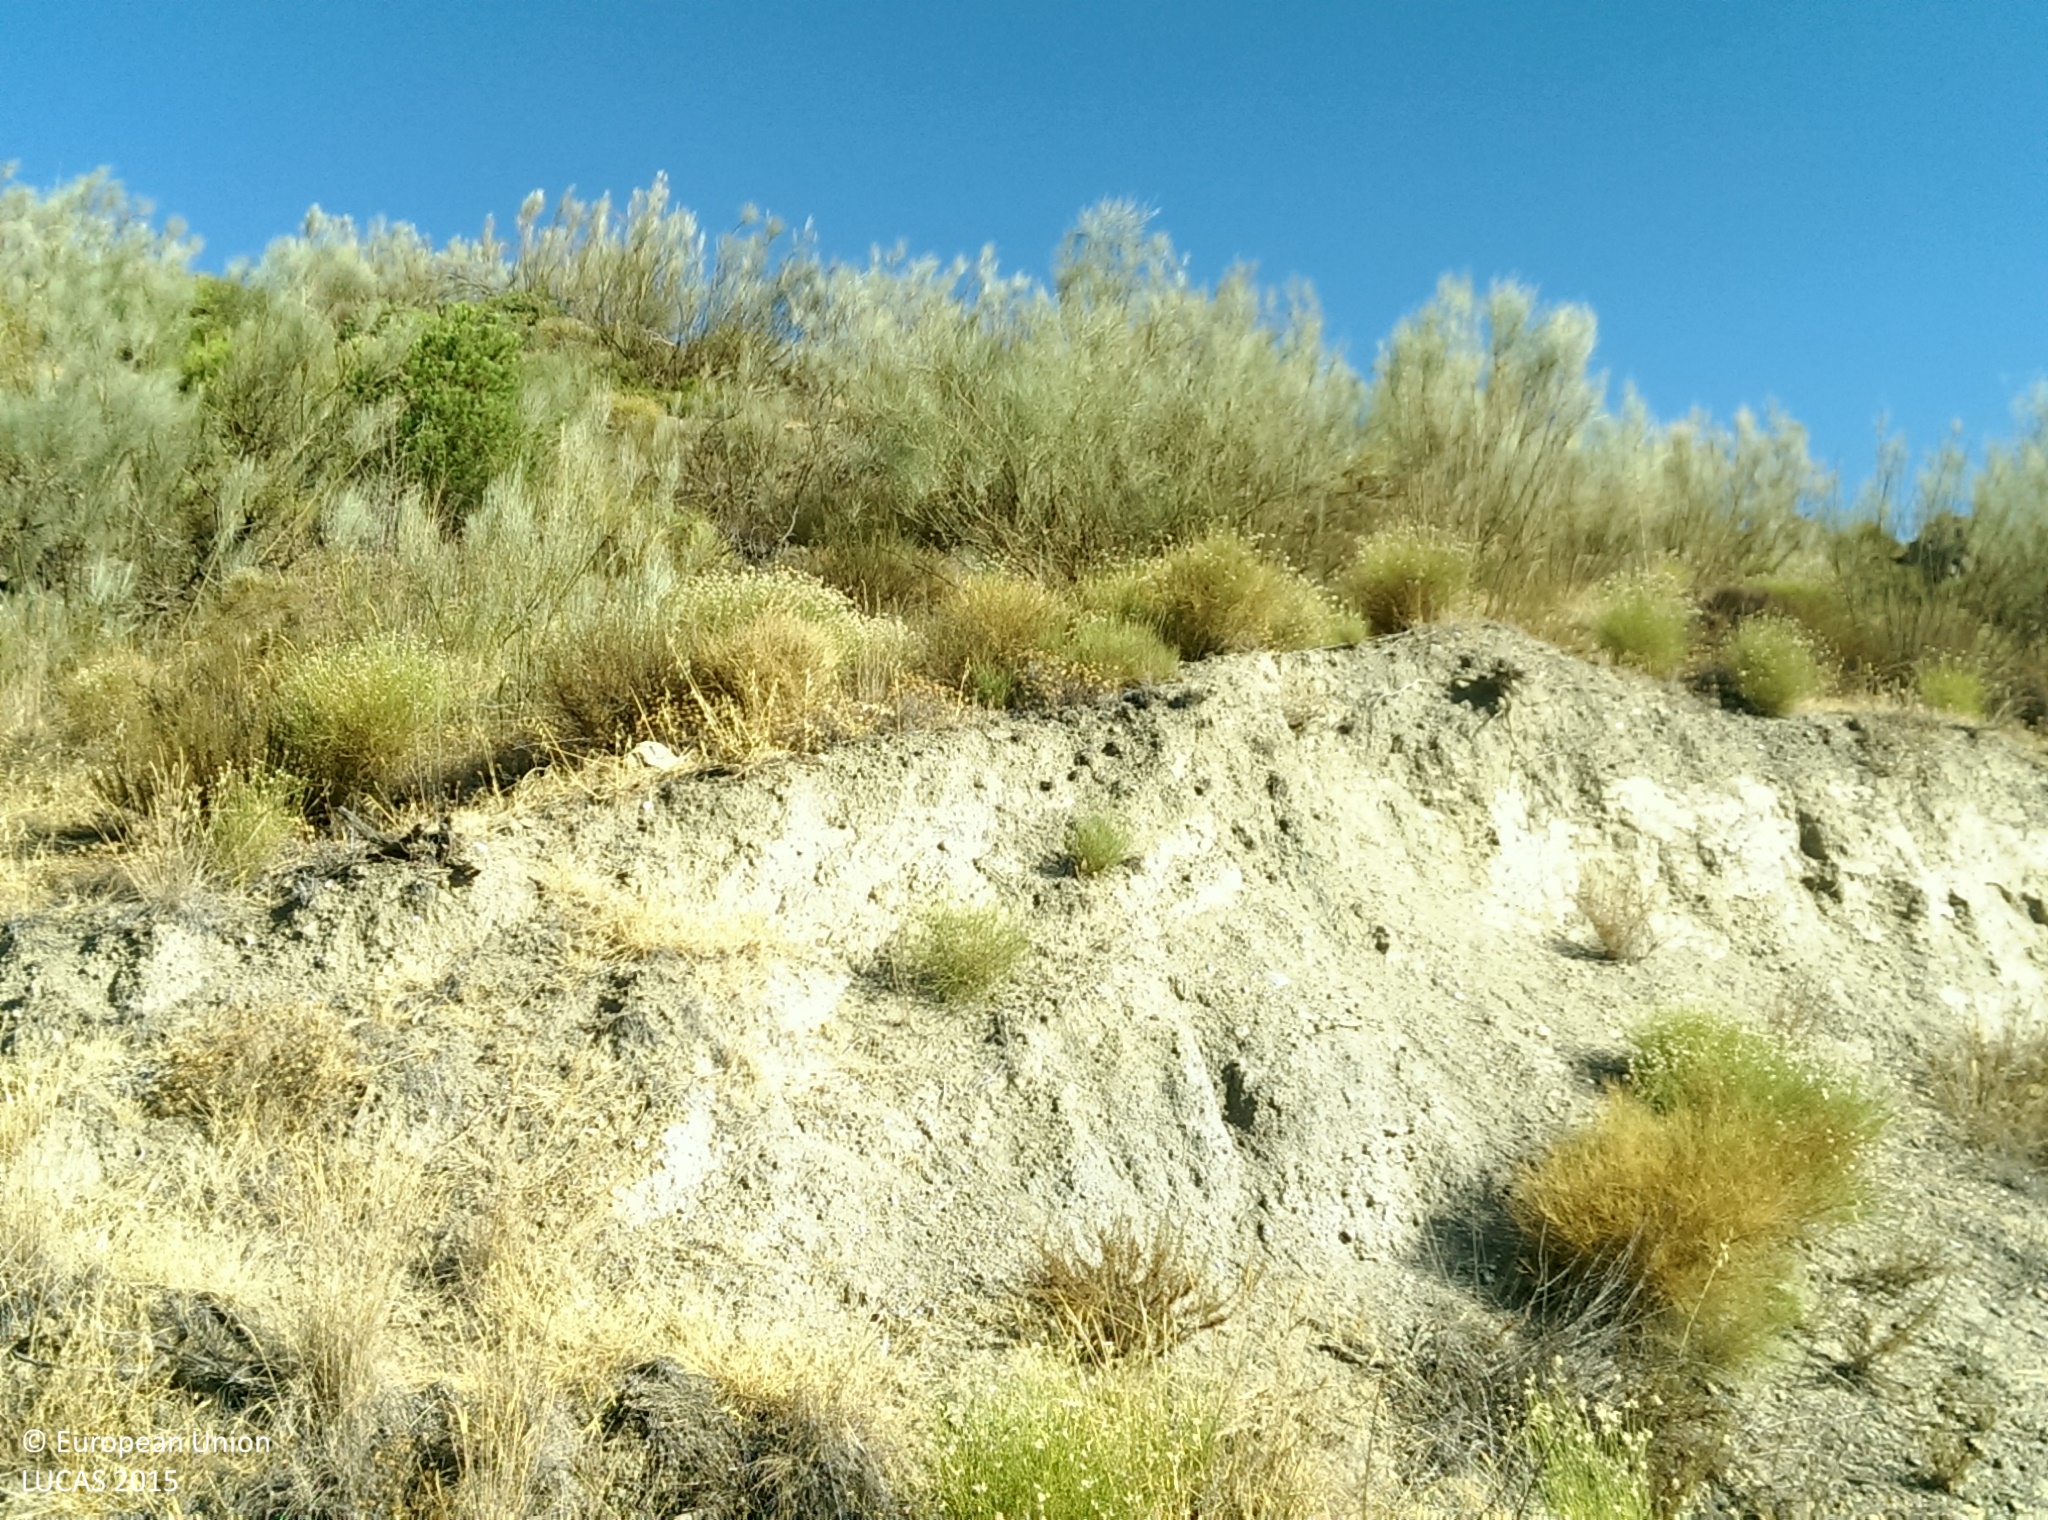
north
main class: Shrubland
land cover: Shrubland with sparse tree cover
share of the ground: 50 - 75 %
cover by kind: shrubs 60 %, herbaceous plants 30 %, coniferous forest trees 5 %, unconsolidated bare surface 5 %
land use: Semi-natural and natural areas not in use
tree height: < 5 m
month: August
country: ES
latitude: 36.8536
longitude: -3.1133
